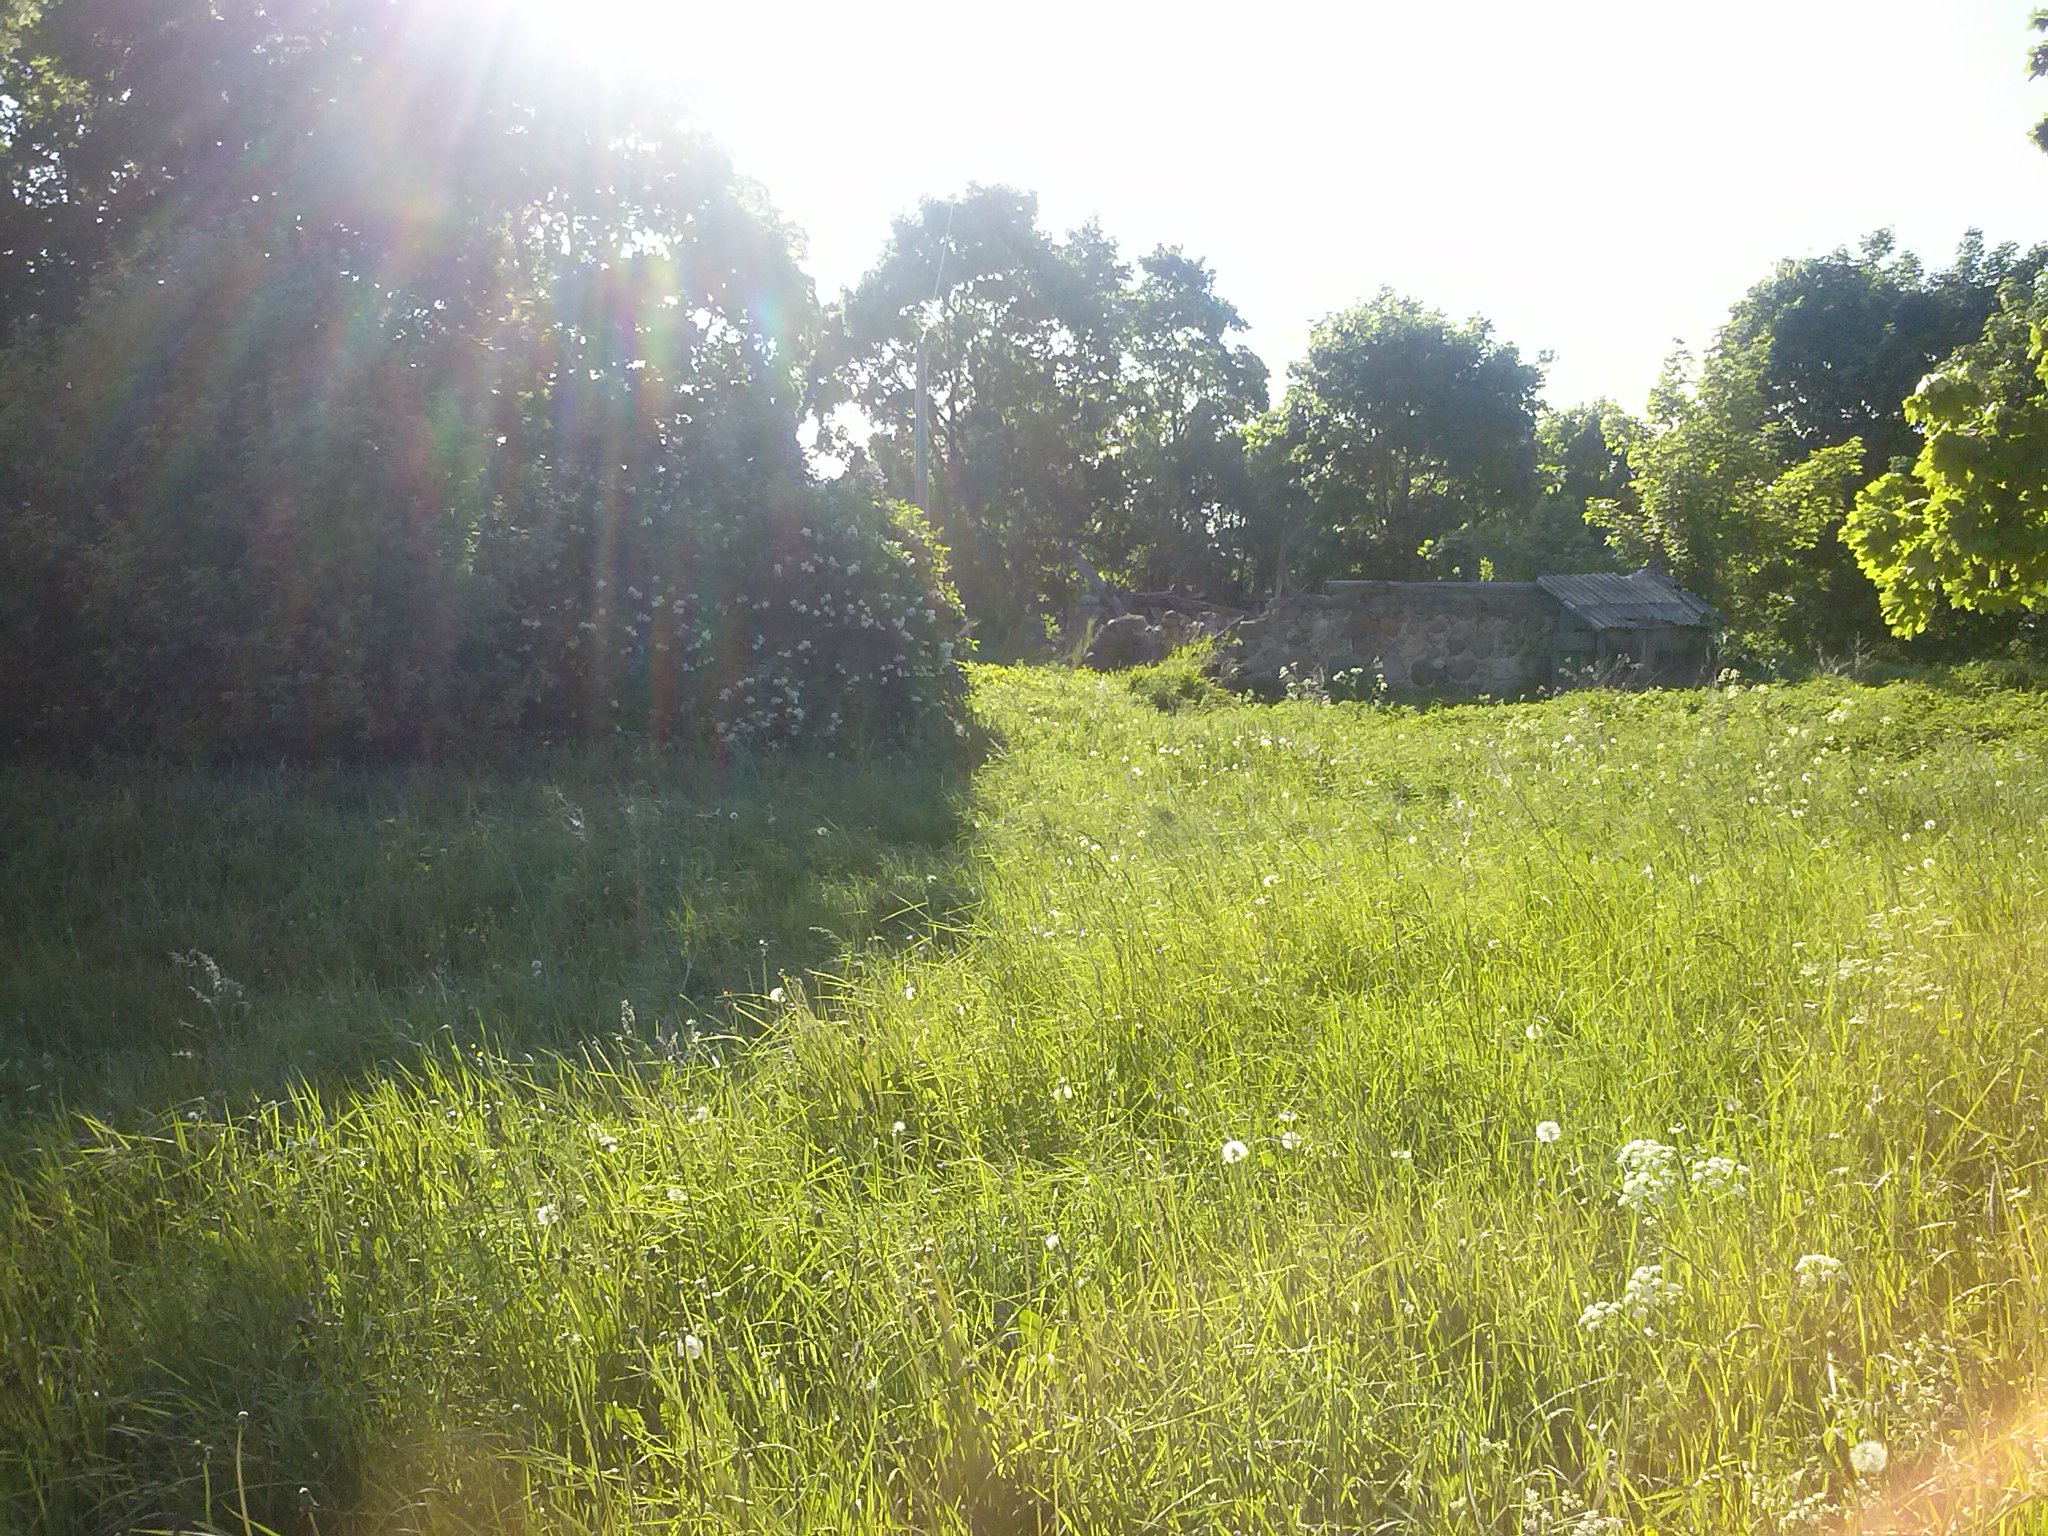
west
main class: Grassland
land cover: Grassland without tree/shrub cover
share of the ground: > 75 %
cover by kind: herbaceous plants 100 %
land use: Agriculture (excluding fallow land and kitchen gardens)
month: June
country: LV
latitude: 56.3442
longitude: 27.7090
